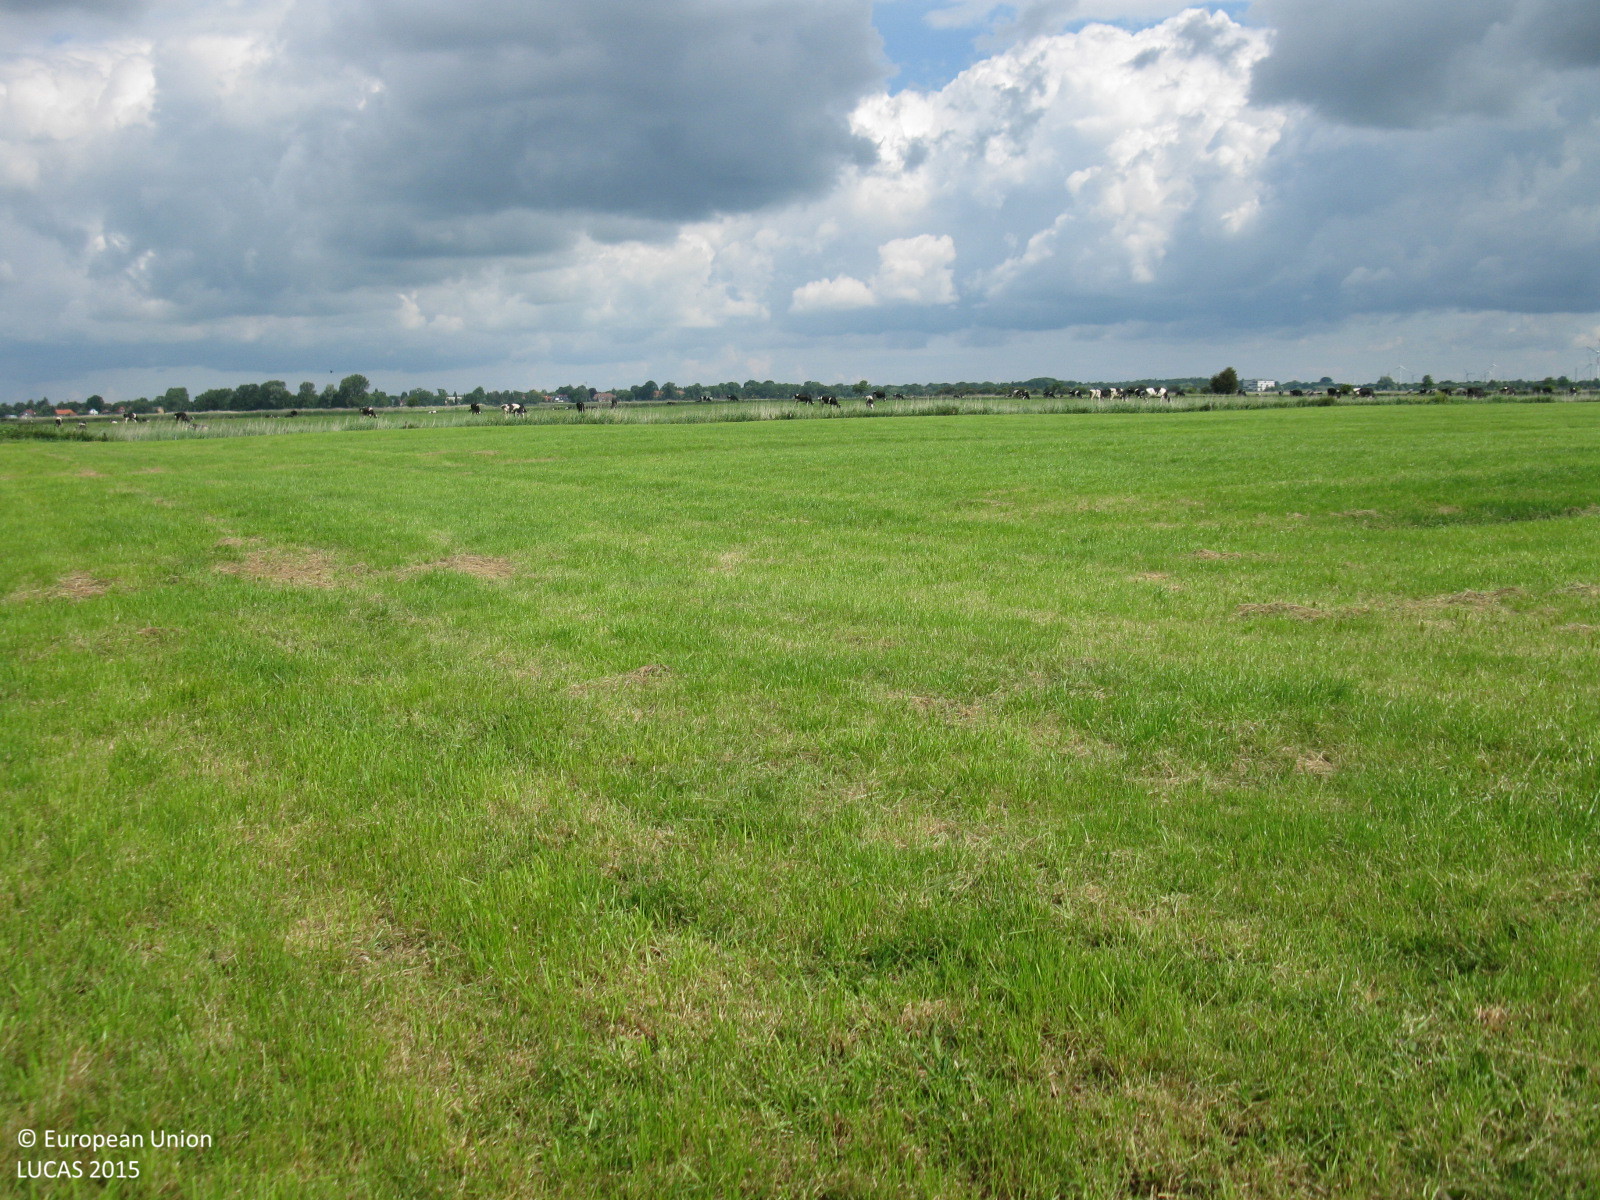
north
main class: Grassland
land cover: Grassland without tree/shrub cover
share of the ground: > 75 %
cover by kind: herbaceous plants 100 %
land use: Agriculture (excluding fallow land and kitchen gardens)
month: June
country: DE
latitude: 53.5107
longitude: 7.9650
